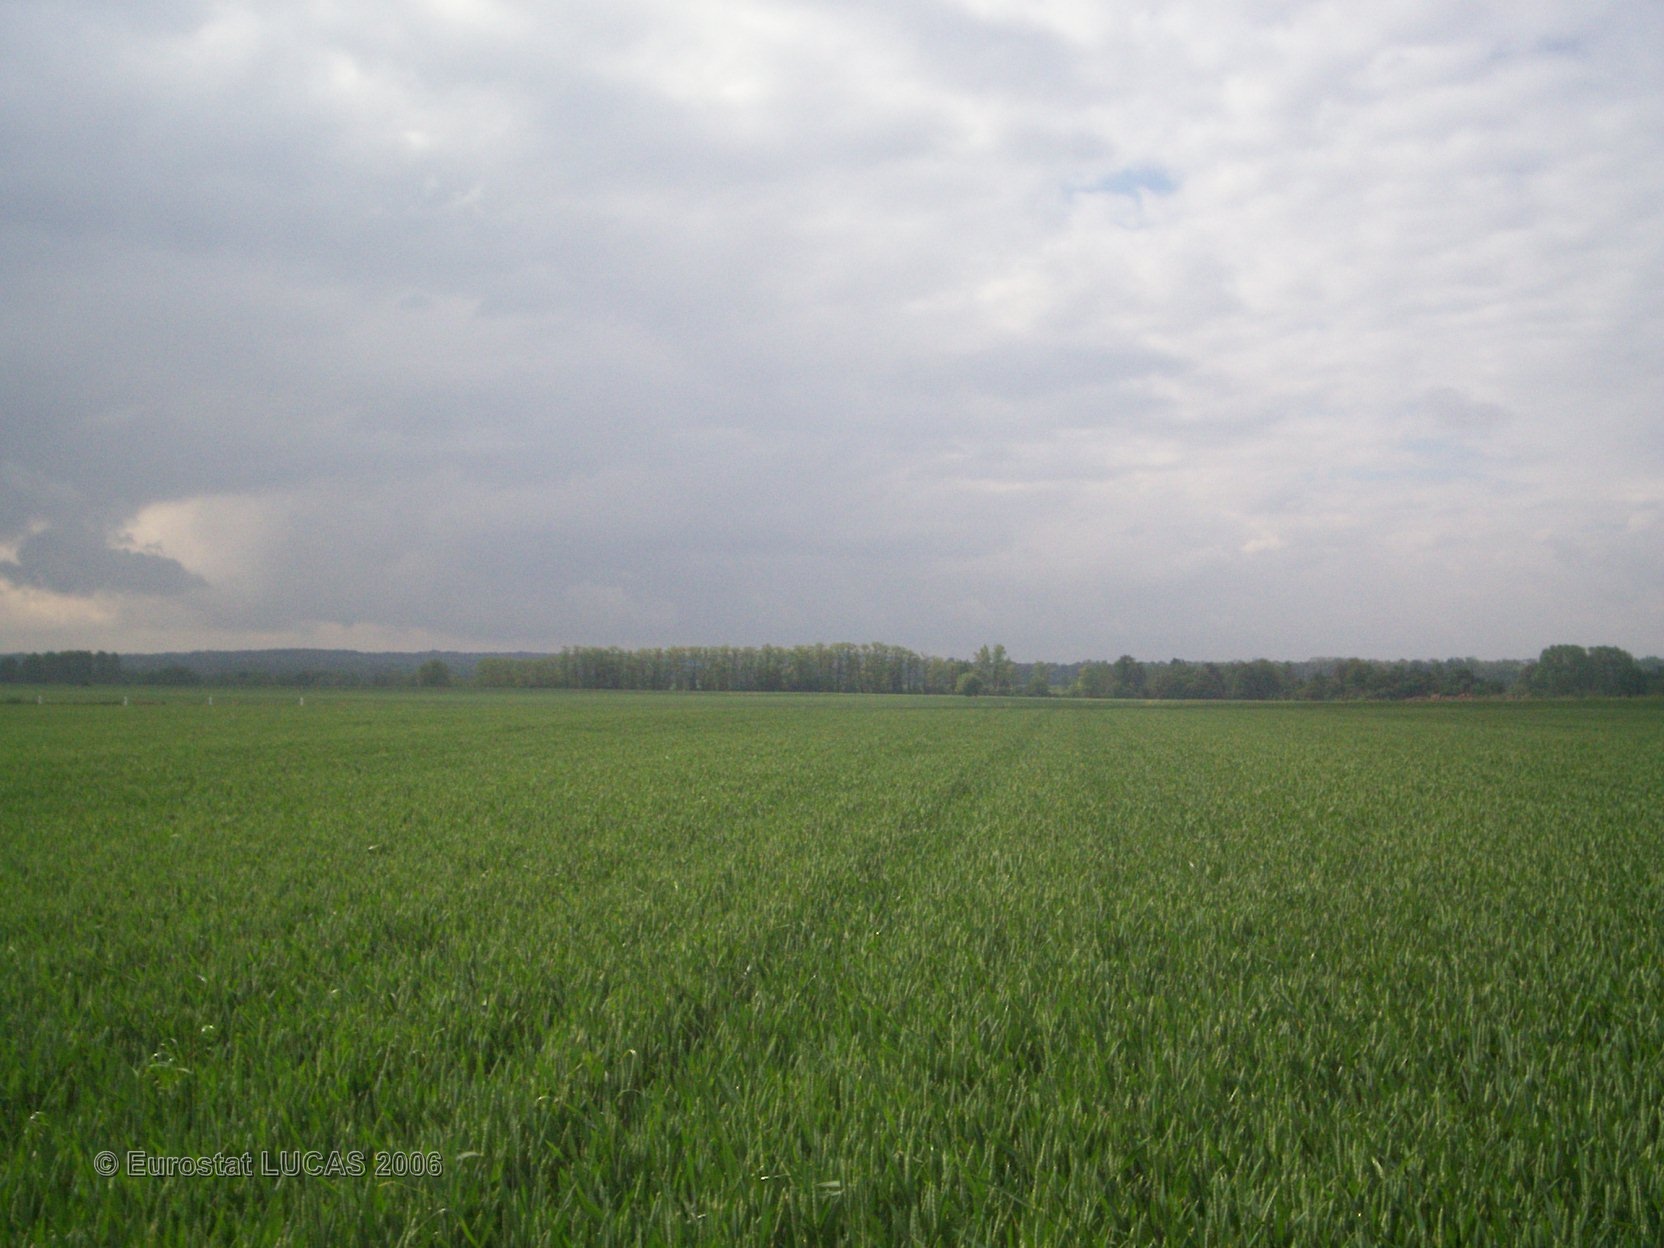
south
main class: Cropland
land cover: Common wheat
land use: Agriculture (excluding fallow land and kitchen gardens)
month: May
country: FR
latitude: 49.1740
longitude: 2.7058
